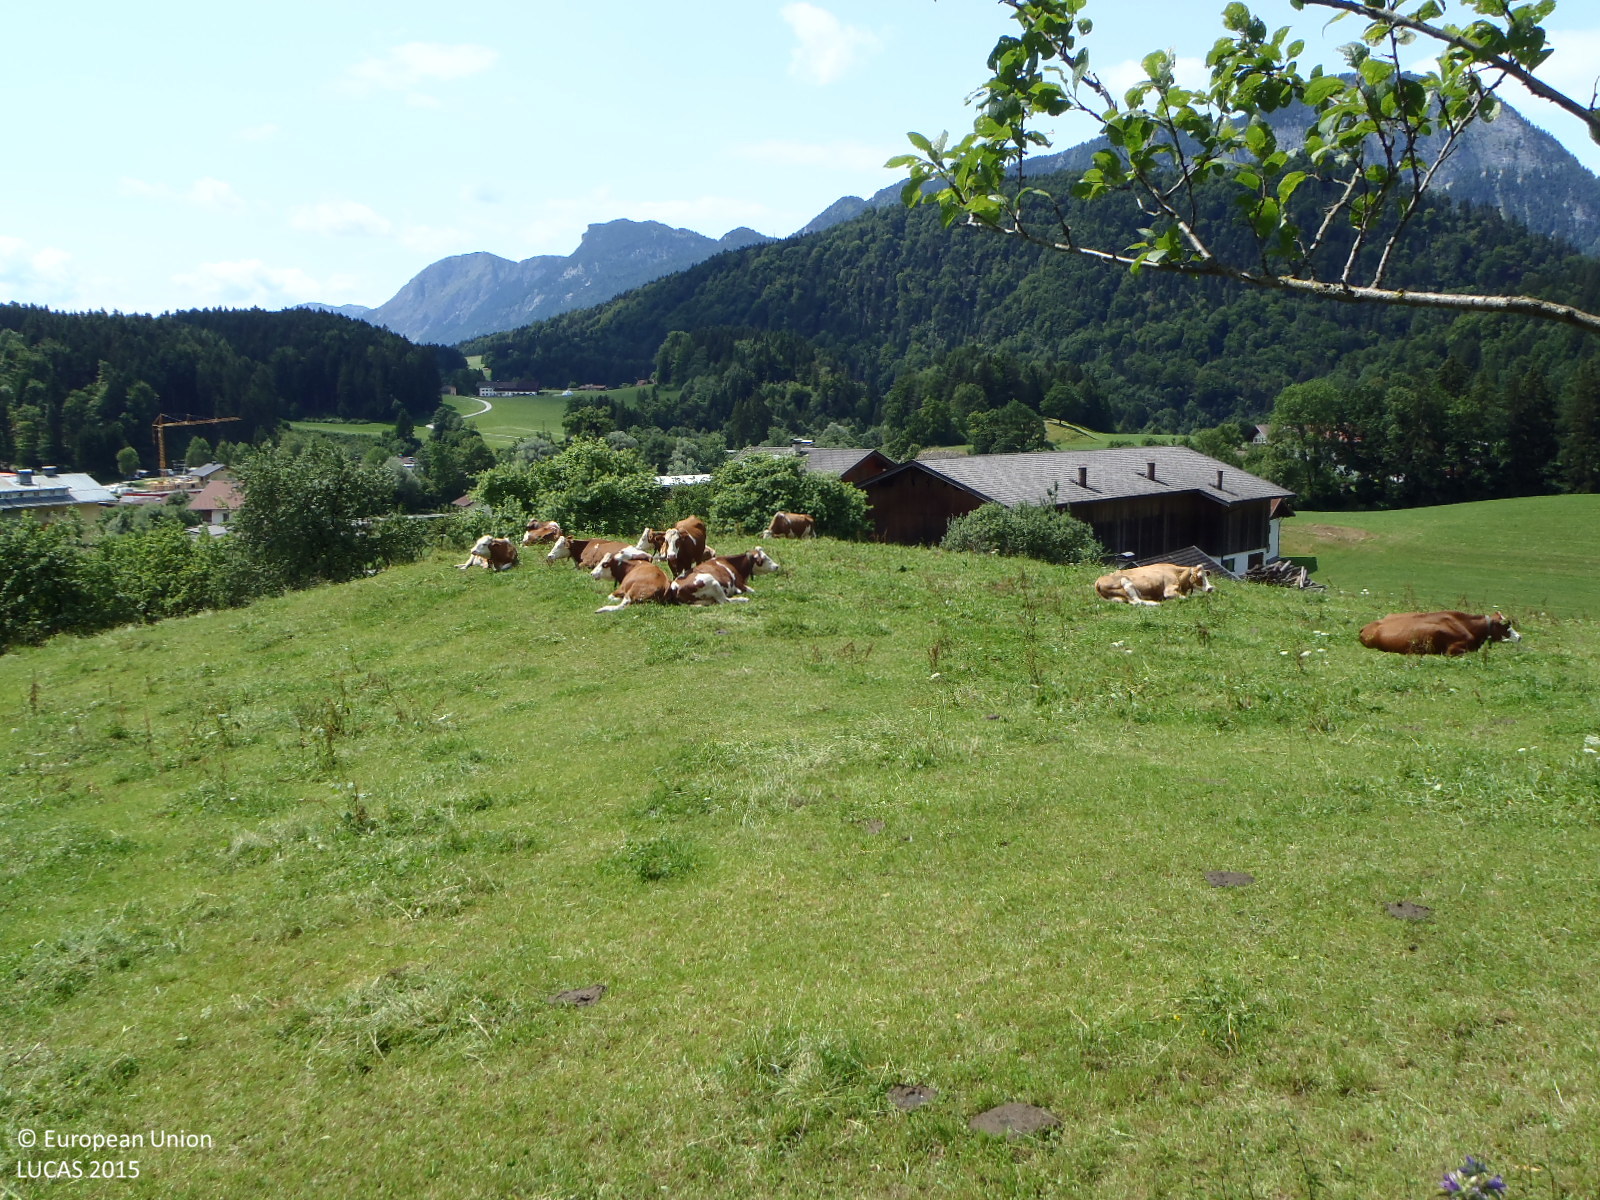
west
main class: Grassland
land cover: Grassland without tree/shrub cover
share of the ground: > 75 %
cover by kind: herbaceous plants 100 %
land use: Agriculture (excluding fallow land and kitchen gardens)
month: July
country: AT
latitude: 47.5542
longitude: 12.1646
